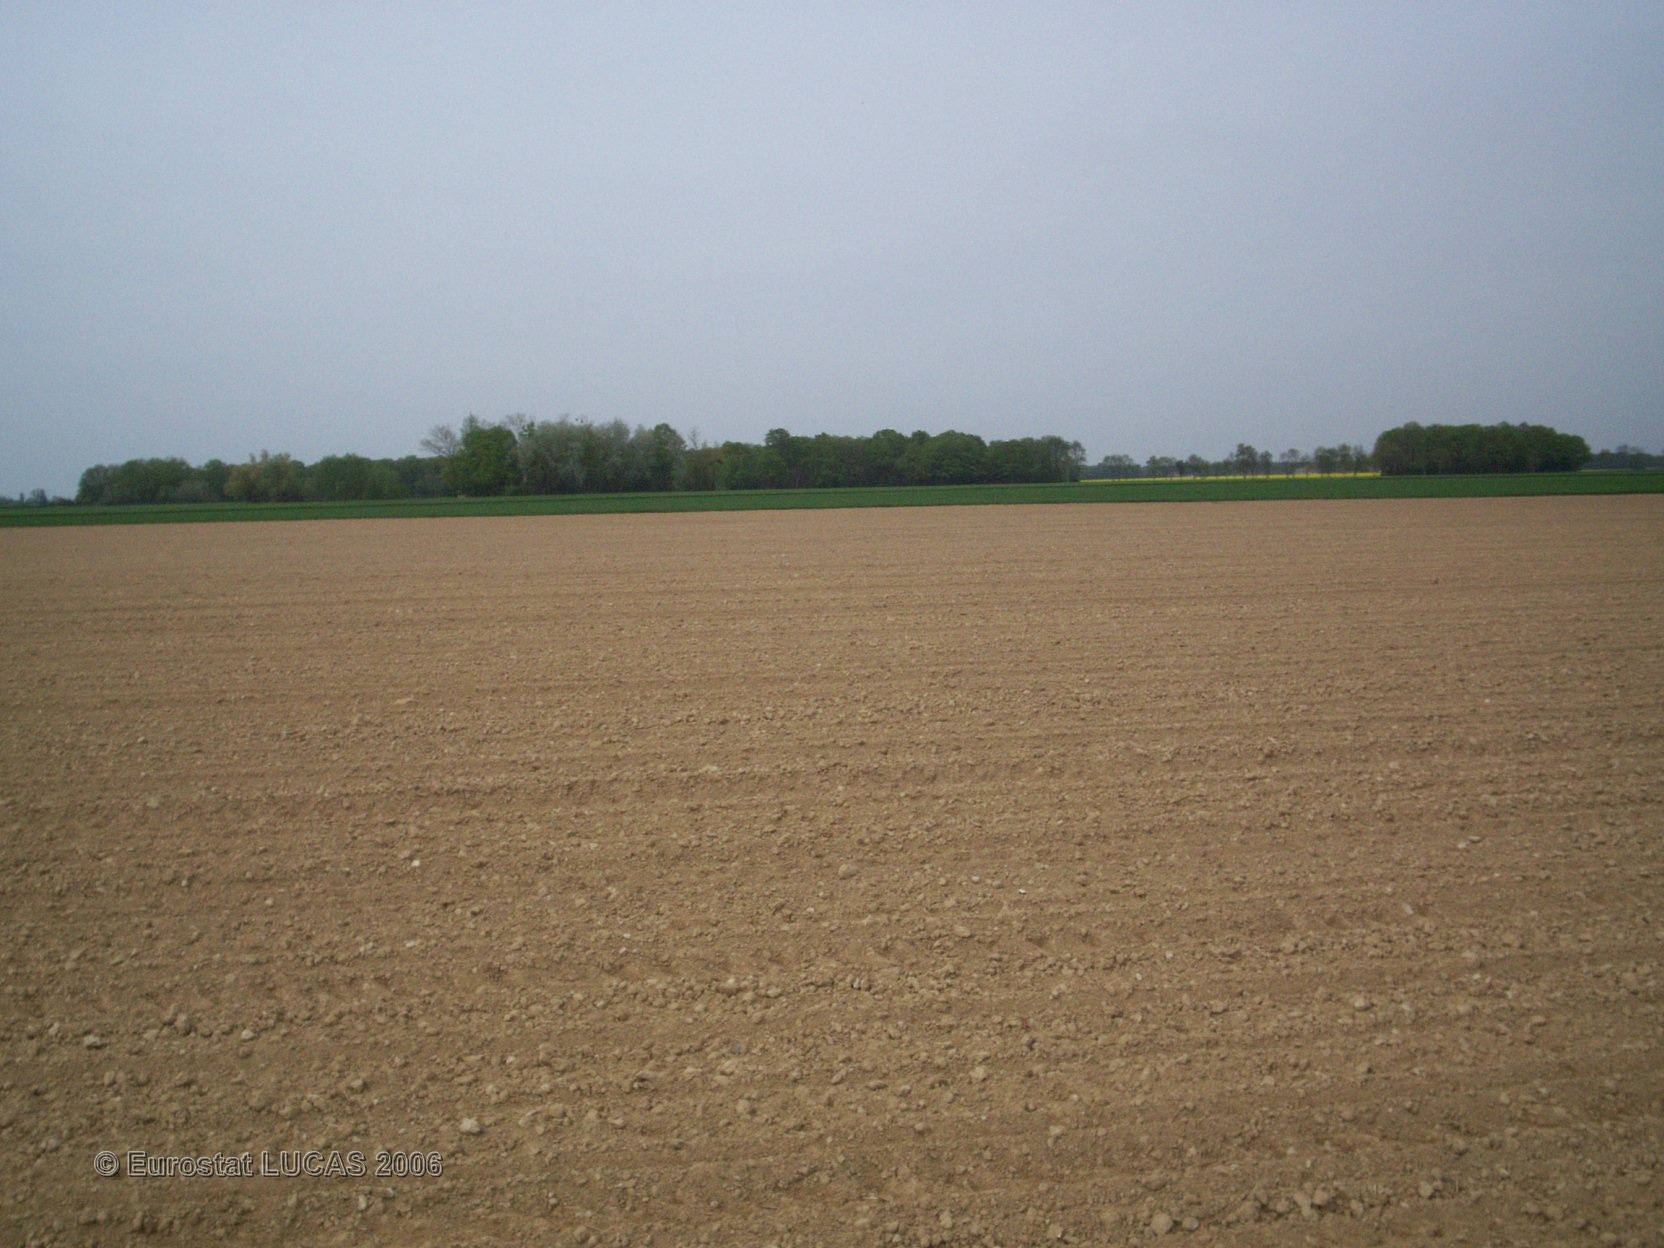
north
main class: Cropland
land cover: Sugar beet
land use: Agriculture (excluding fallow land and kitchen gardens)
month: May
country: FR
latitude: 48.7499
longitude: 2.8503
